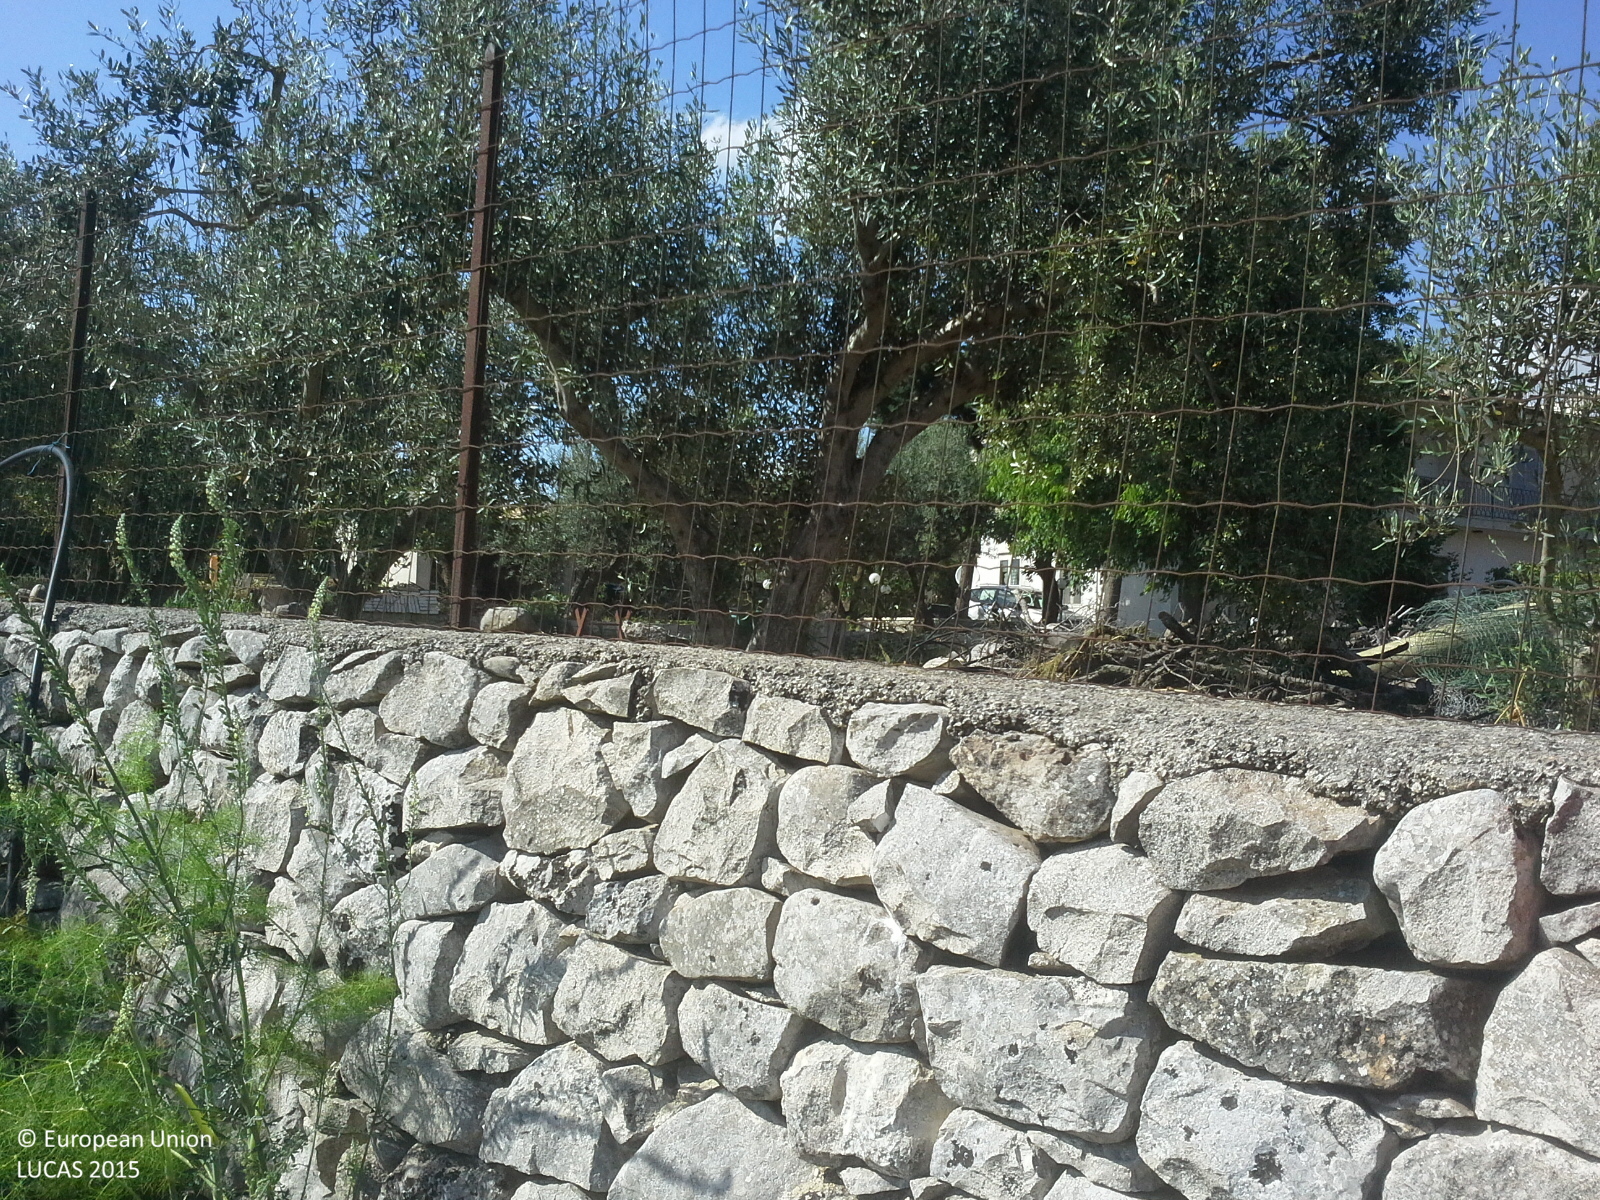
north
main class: Cropland
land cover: Olive groves
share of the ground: > 75 %
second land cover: Spontaneously vegetated surfaces
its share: > 75 %
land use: Agriculture (excluding fallow land and kitchen gardens)
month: May
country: IT
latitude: 36.8274
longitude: 14.7715
